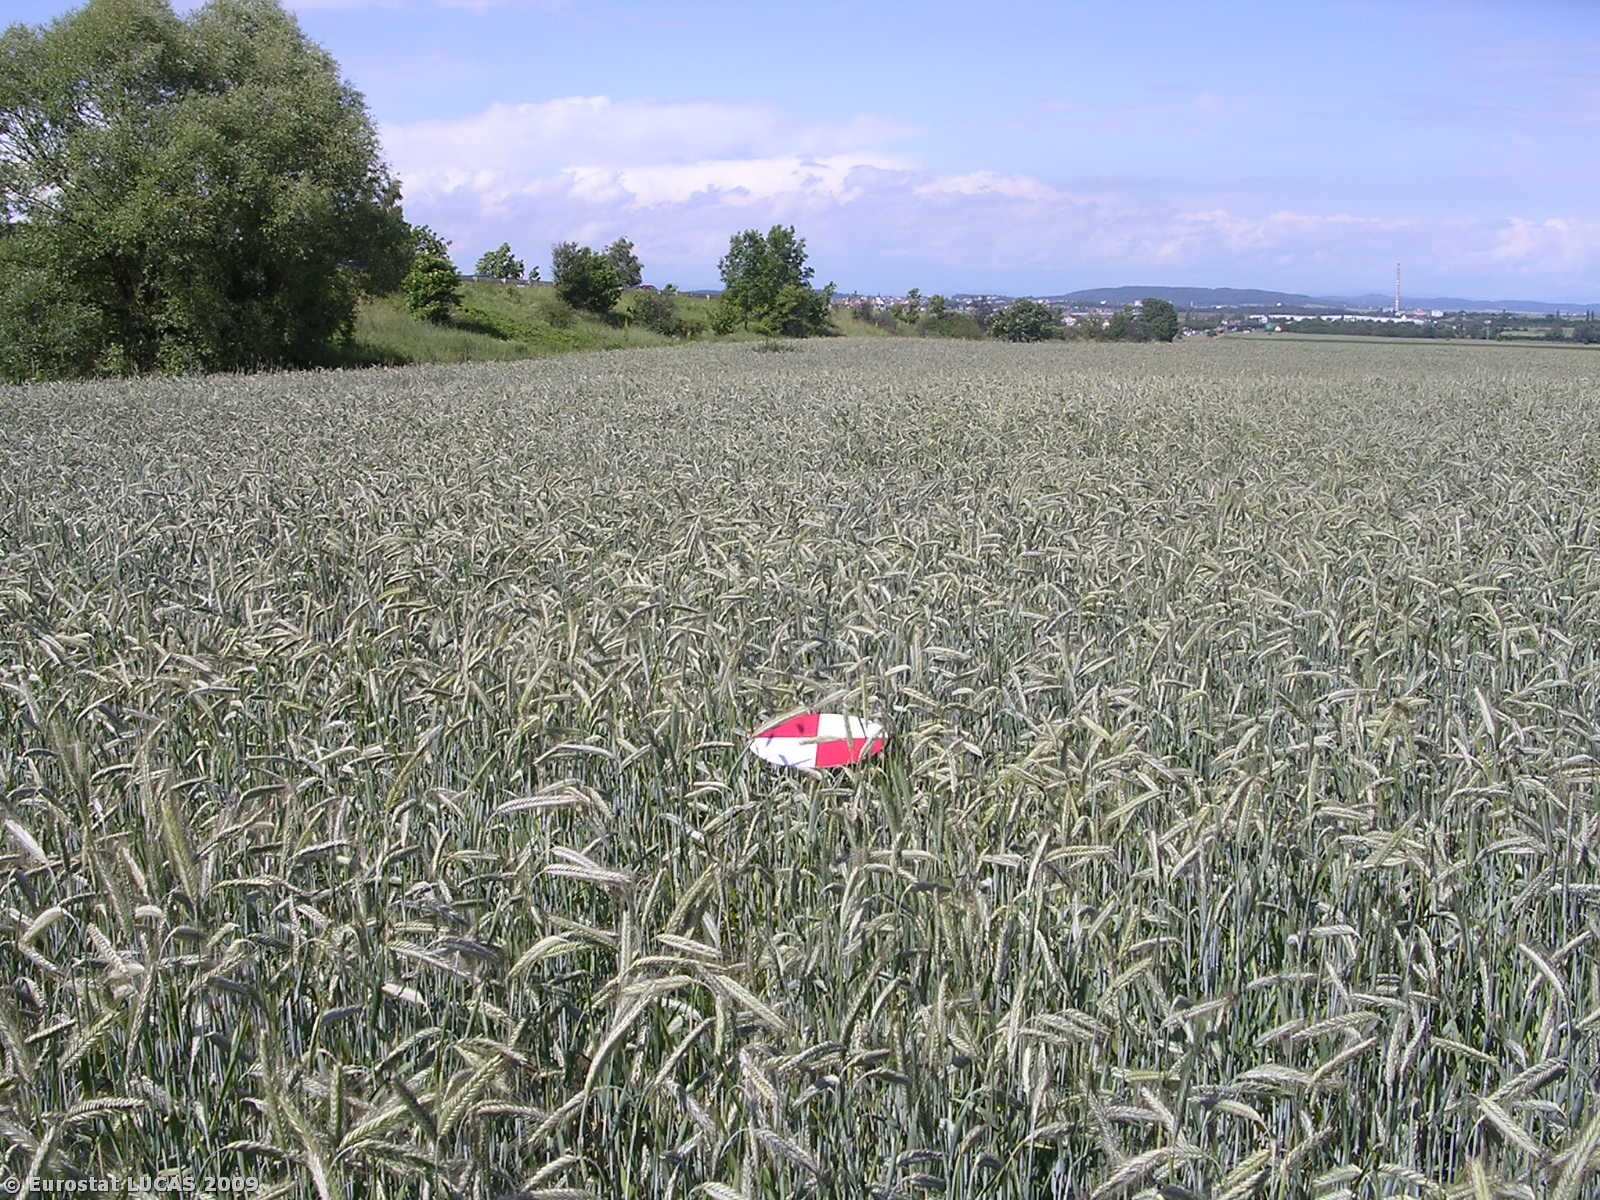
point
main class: Cropland
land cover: Triticale
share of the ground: > 75 %
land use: Agriculture (excluding fallow land and kitchen gardens)
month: June
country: CZ
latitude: 50.3680
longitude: 14.8810
